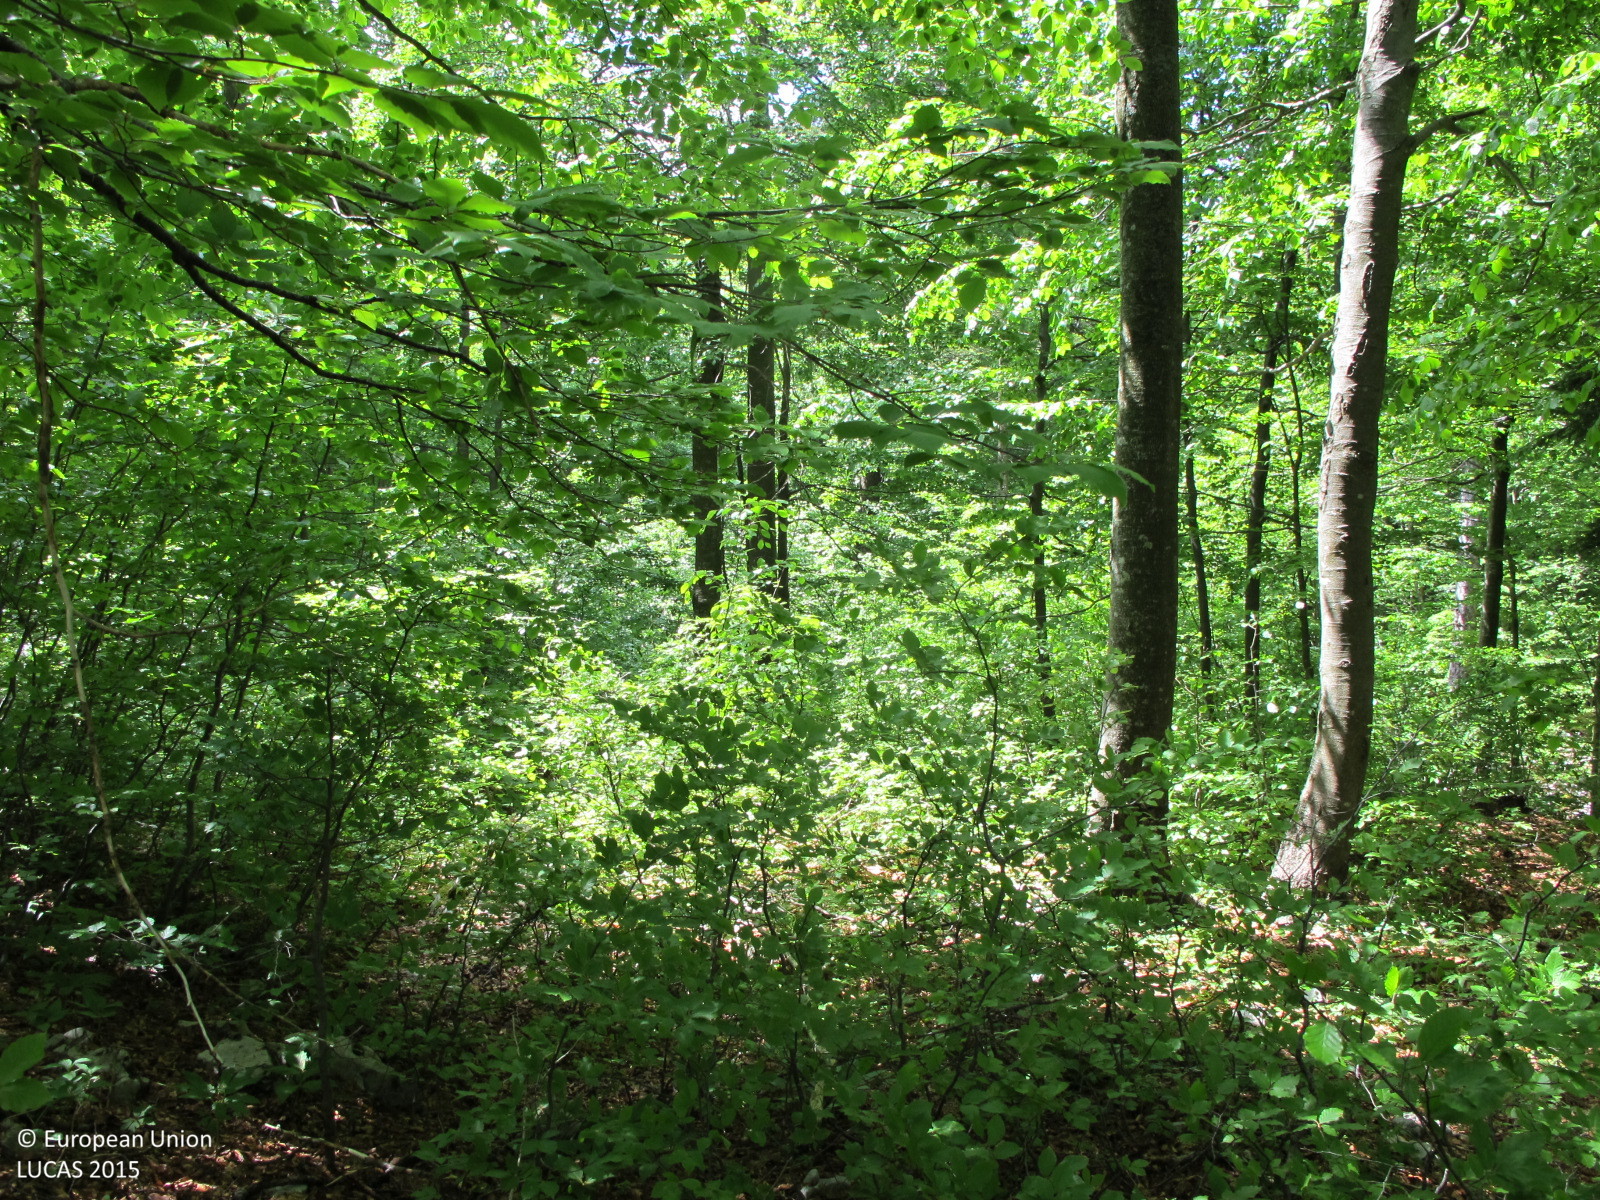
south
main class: Woodland
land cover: Broadleaved woodland
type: mountainous beech forest
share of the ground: > 75 %
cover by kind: broadleaved forest trees 90 %, coniferous forest trees 5 %, shrubs 5 %
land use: Forestry
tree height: > 5 m
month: May
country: HR
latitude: 45.4611
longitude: 14.5353
